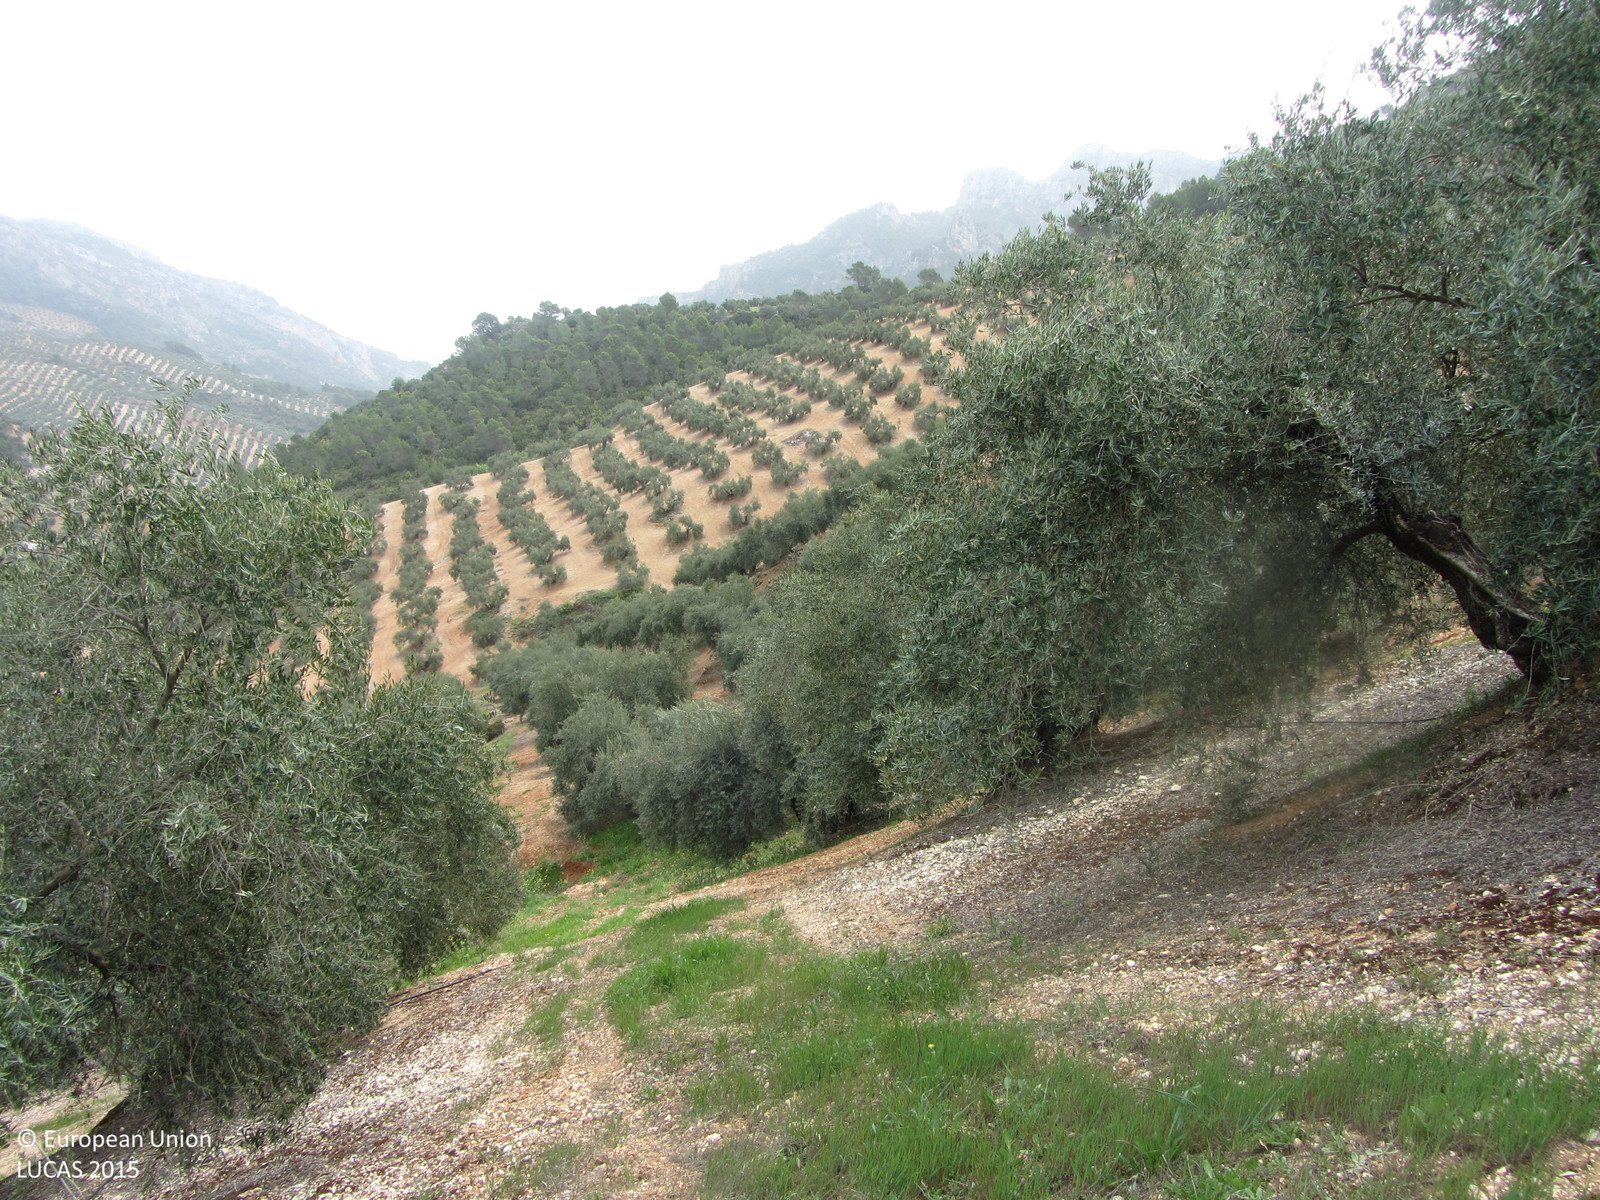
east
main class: Cropland
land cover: Olive groves
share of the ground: 50 - 75 %
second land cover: Spontaneously vegetated surfaces
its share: 10 - 25 %
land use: Agriculture (excluding fallow land and kitchen gardens)
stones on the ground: > 50 %
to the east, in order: Olive groves; Spontaneously vegetated surfaces; Electric lines; Olive groves; Rock outcrops; Olive groves; Tracks; Olive groves; Tracks; Olive groves; Rivers and streams; Olive groves; Other structural elements; Olive groves
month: April
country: ES
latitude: 38.0820
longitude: -2.9828
